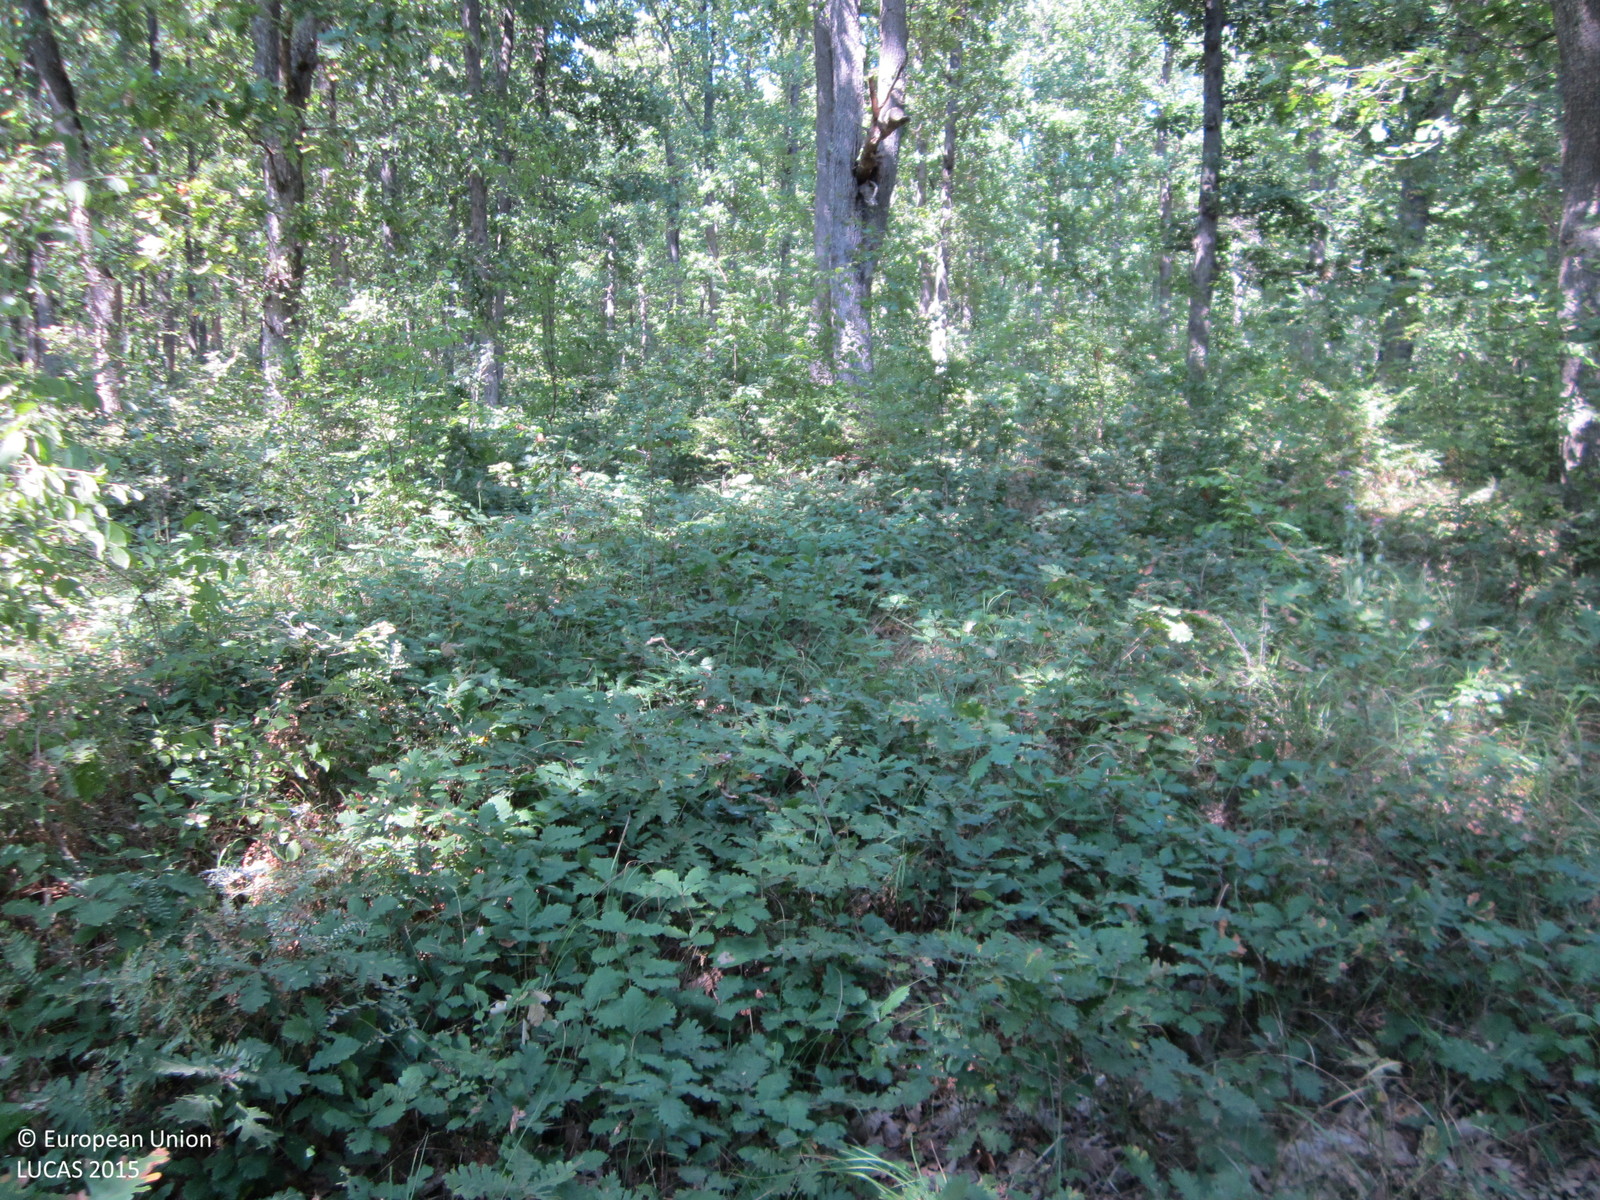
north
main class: Woodland
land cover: Broadleaved woodland
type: thermophilous deciduous forest
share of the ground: > 75 %
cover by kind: broadleaved forest trees 80 %, shrubs 10 %, herbaceous plants 10 %
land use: Forestry
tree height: > 5 m
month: August
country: BG
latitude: 42.8184
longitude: 27.7790
